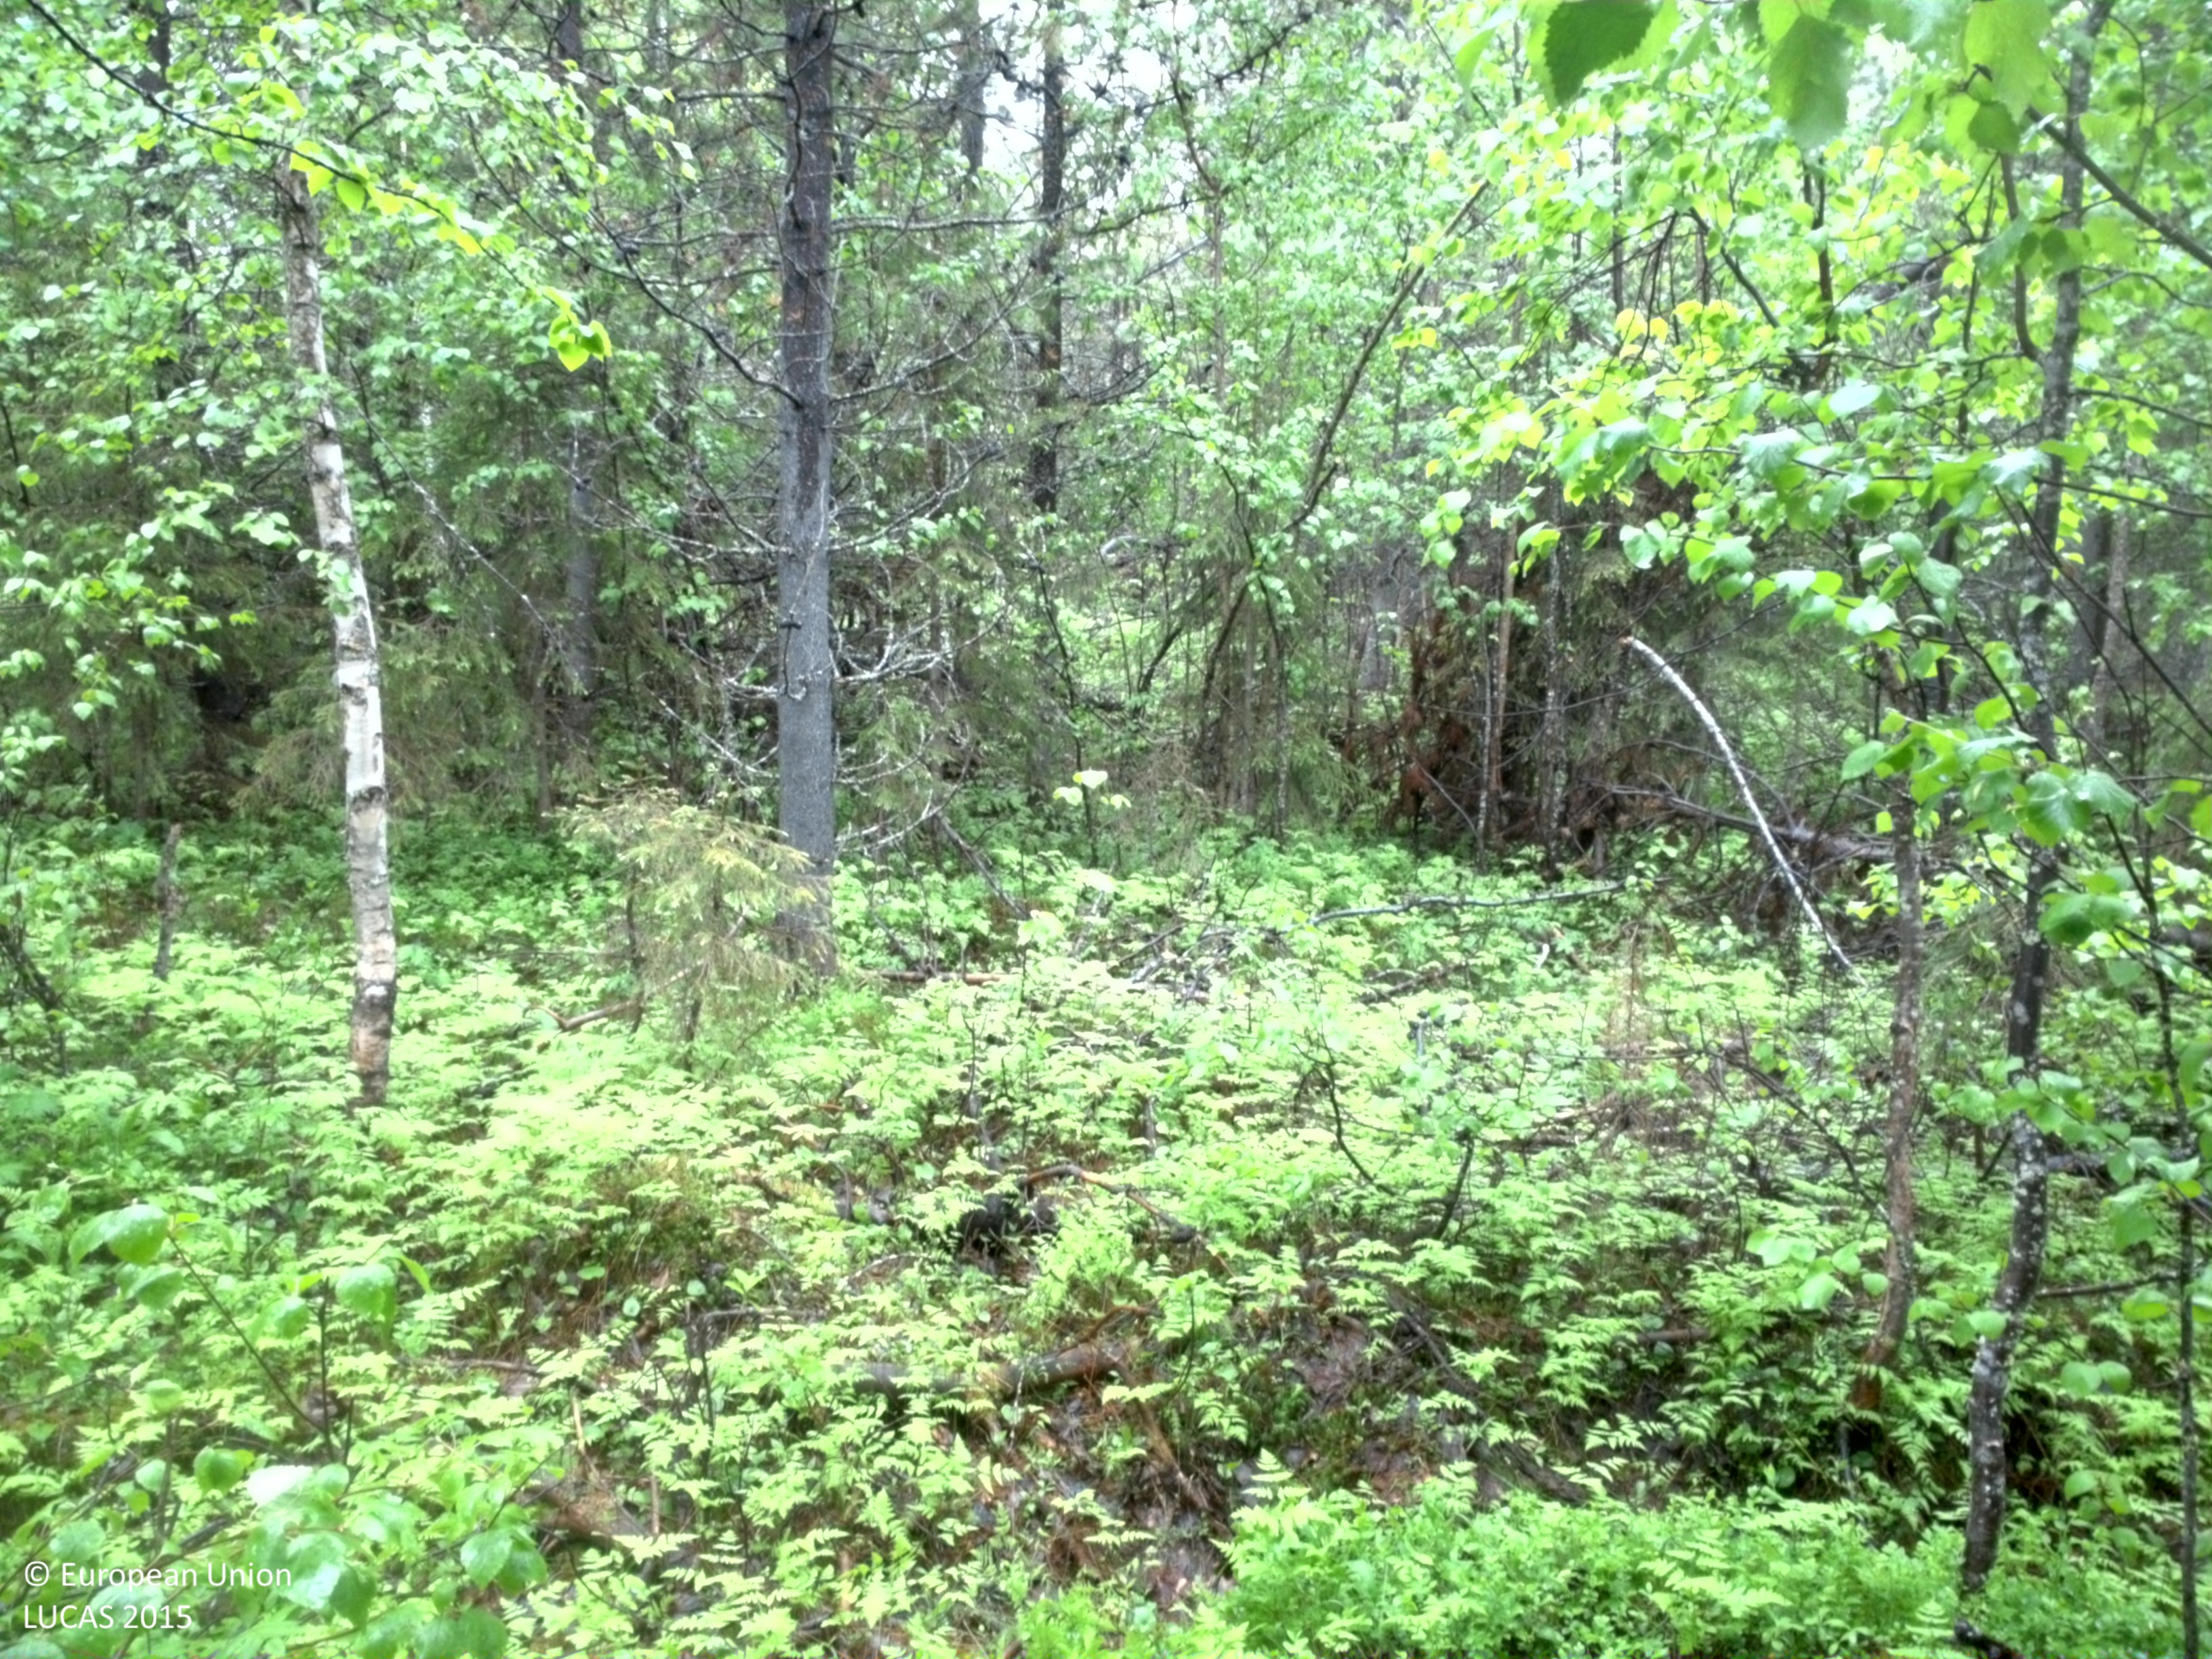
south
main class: Woodland
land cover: Pine dominated mixed woodland
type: exotic forest
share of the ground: > 75 %
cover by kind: coniferous forest trees 40 %, broadleaved forest trees 40 %, shrubs 10 %, herbaceous plants 10 %
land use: Forestry
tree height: > 5 m
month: June
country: SE
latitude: 66.5776
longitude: 22.8016
